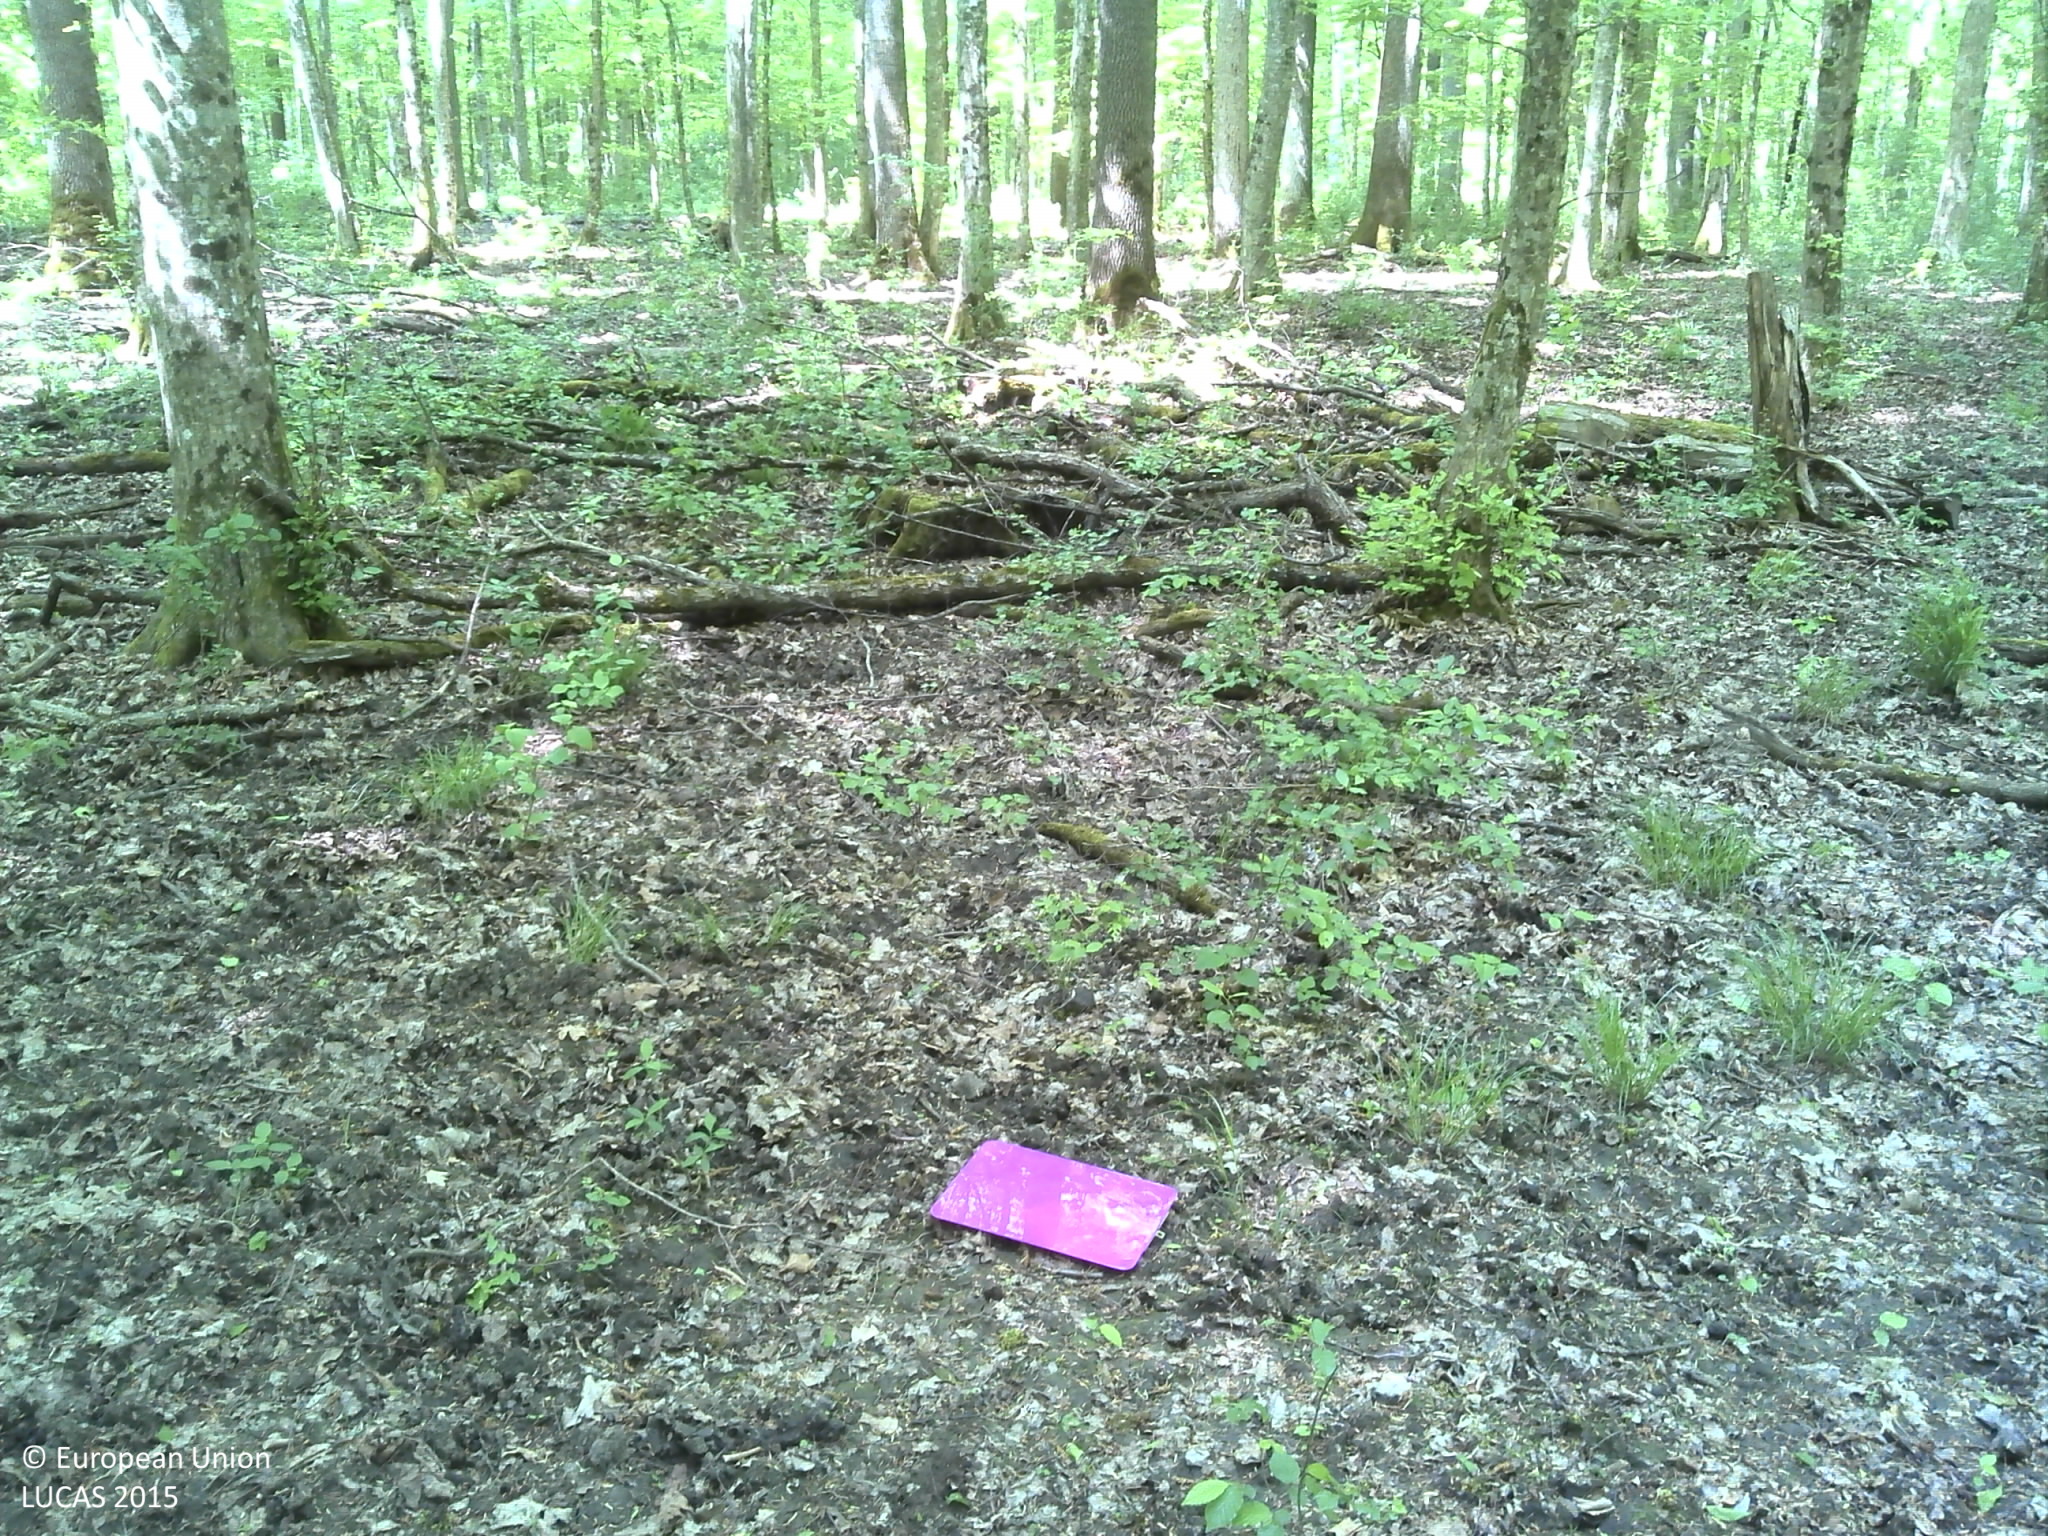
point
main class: Woodland
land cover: Broadleaved woodland
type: mesophytic deciduous forest
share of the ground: > 75 %
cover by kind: broadleaved forest trees 100 %
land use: Forestry
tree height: > 5 m
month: April
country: HR
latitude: 45.0504
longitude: 18.9585
